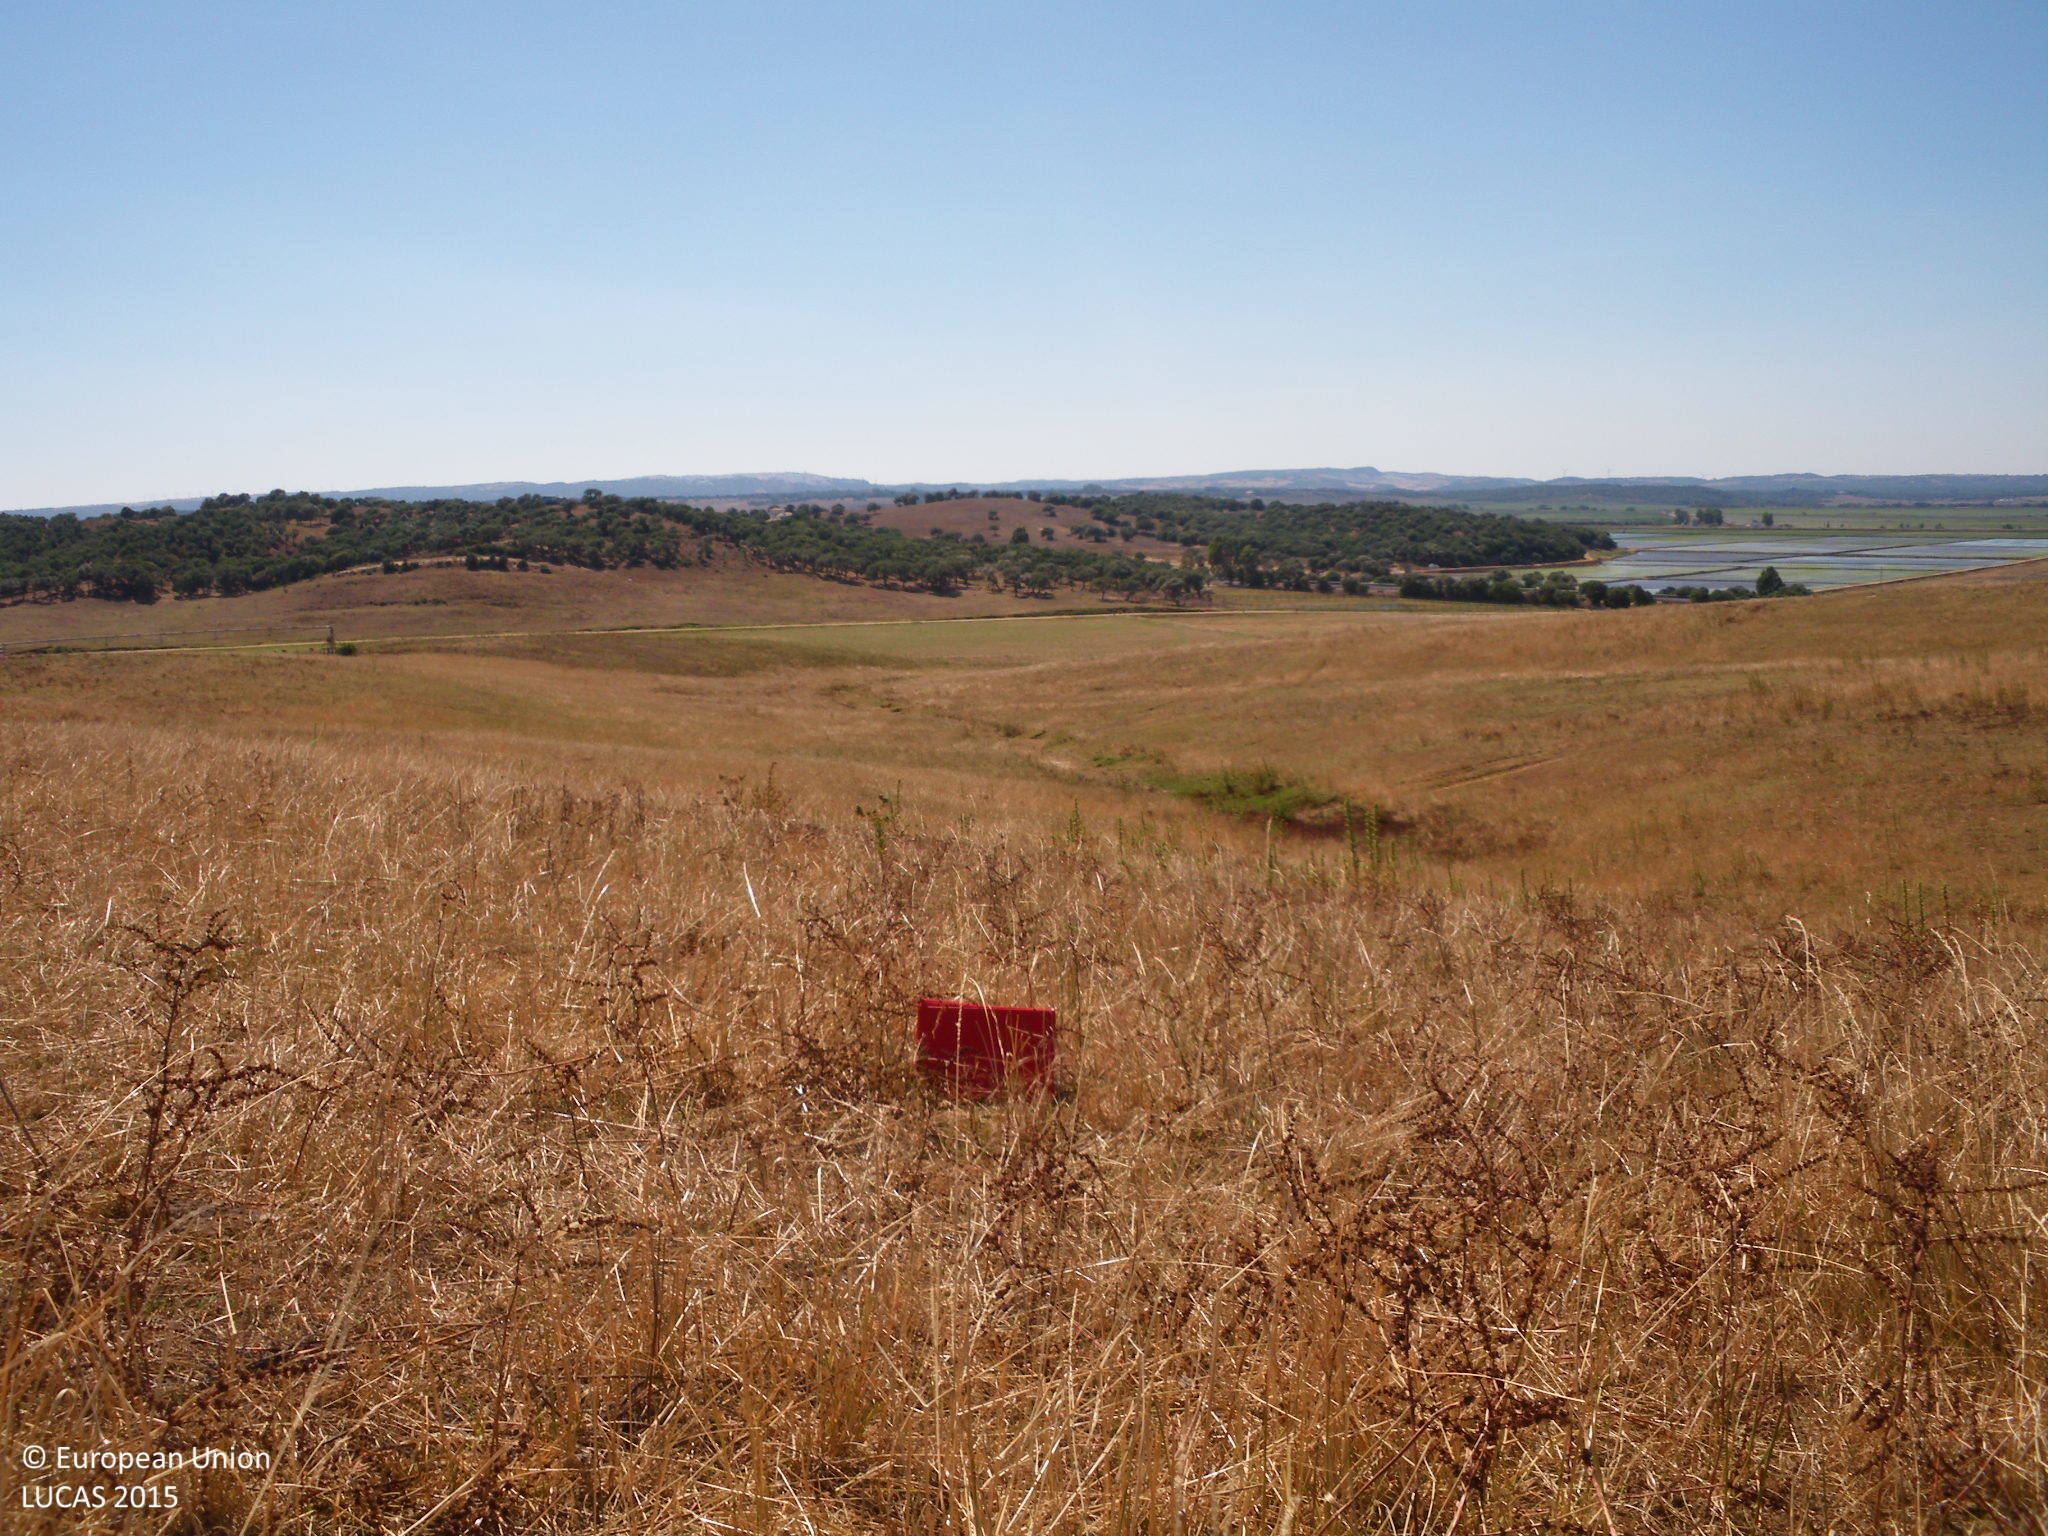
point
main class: Grassland
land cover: Spontaneously vegetated surfaces
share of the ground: > 75 %
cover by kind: herbaceous plants 100 %
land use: Fallow land
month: June
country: ES
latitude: 36.2281
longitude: -5.8300
